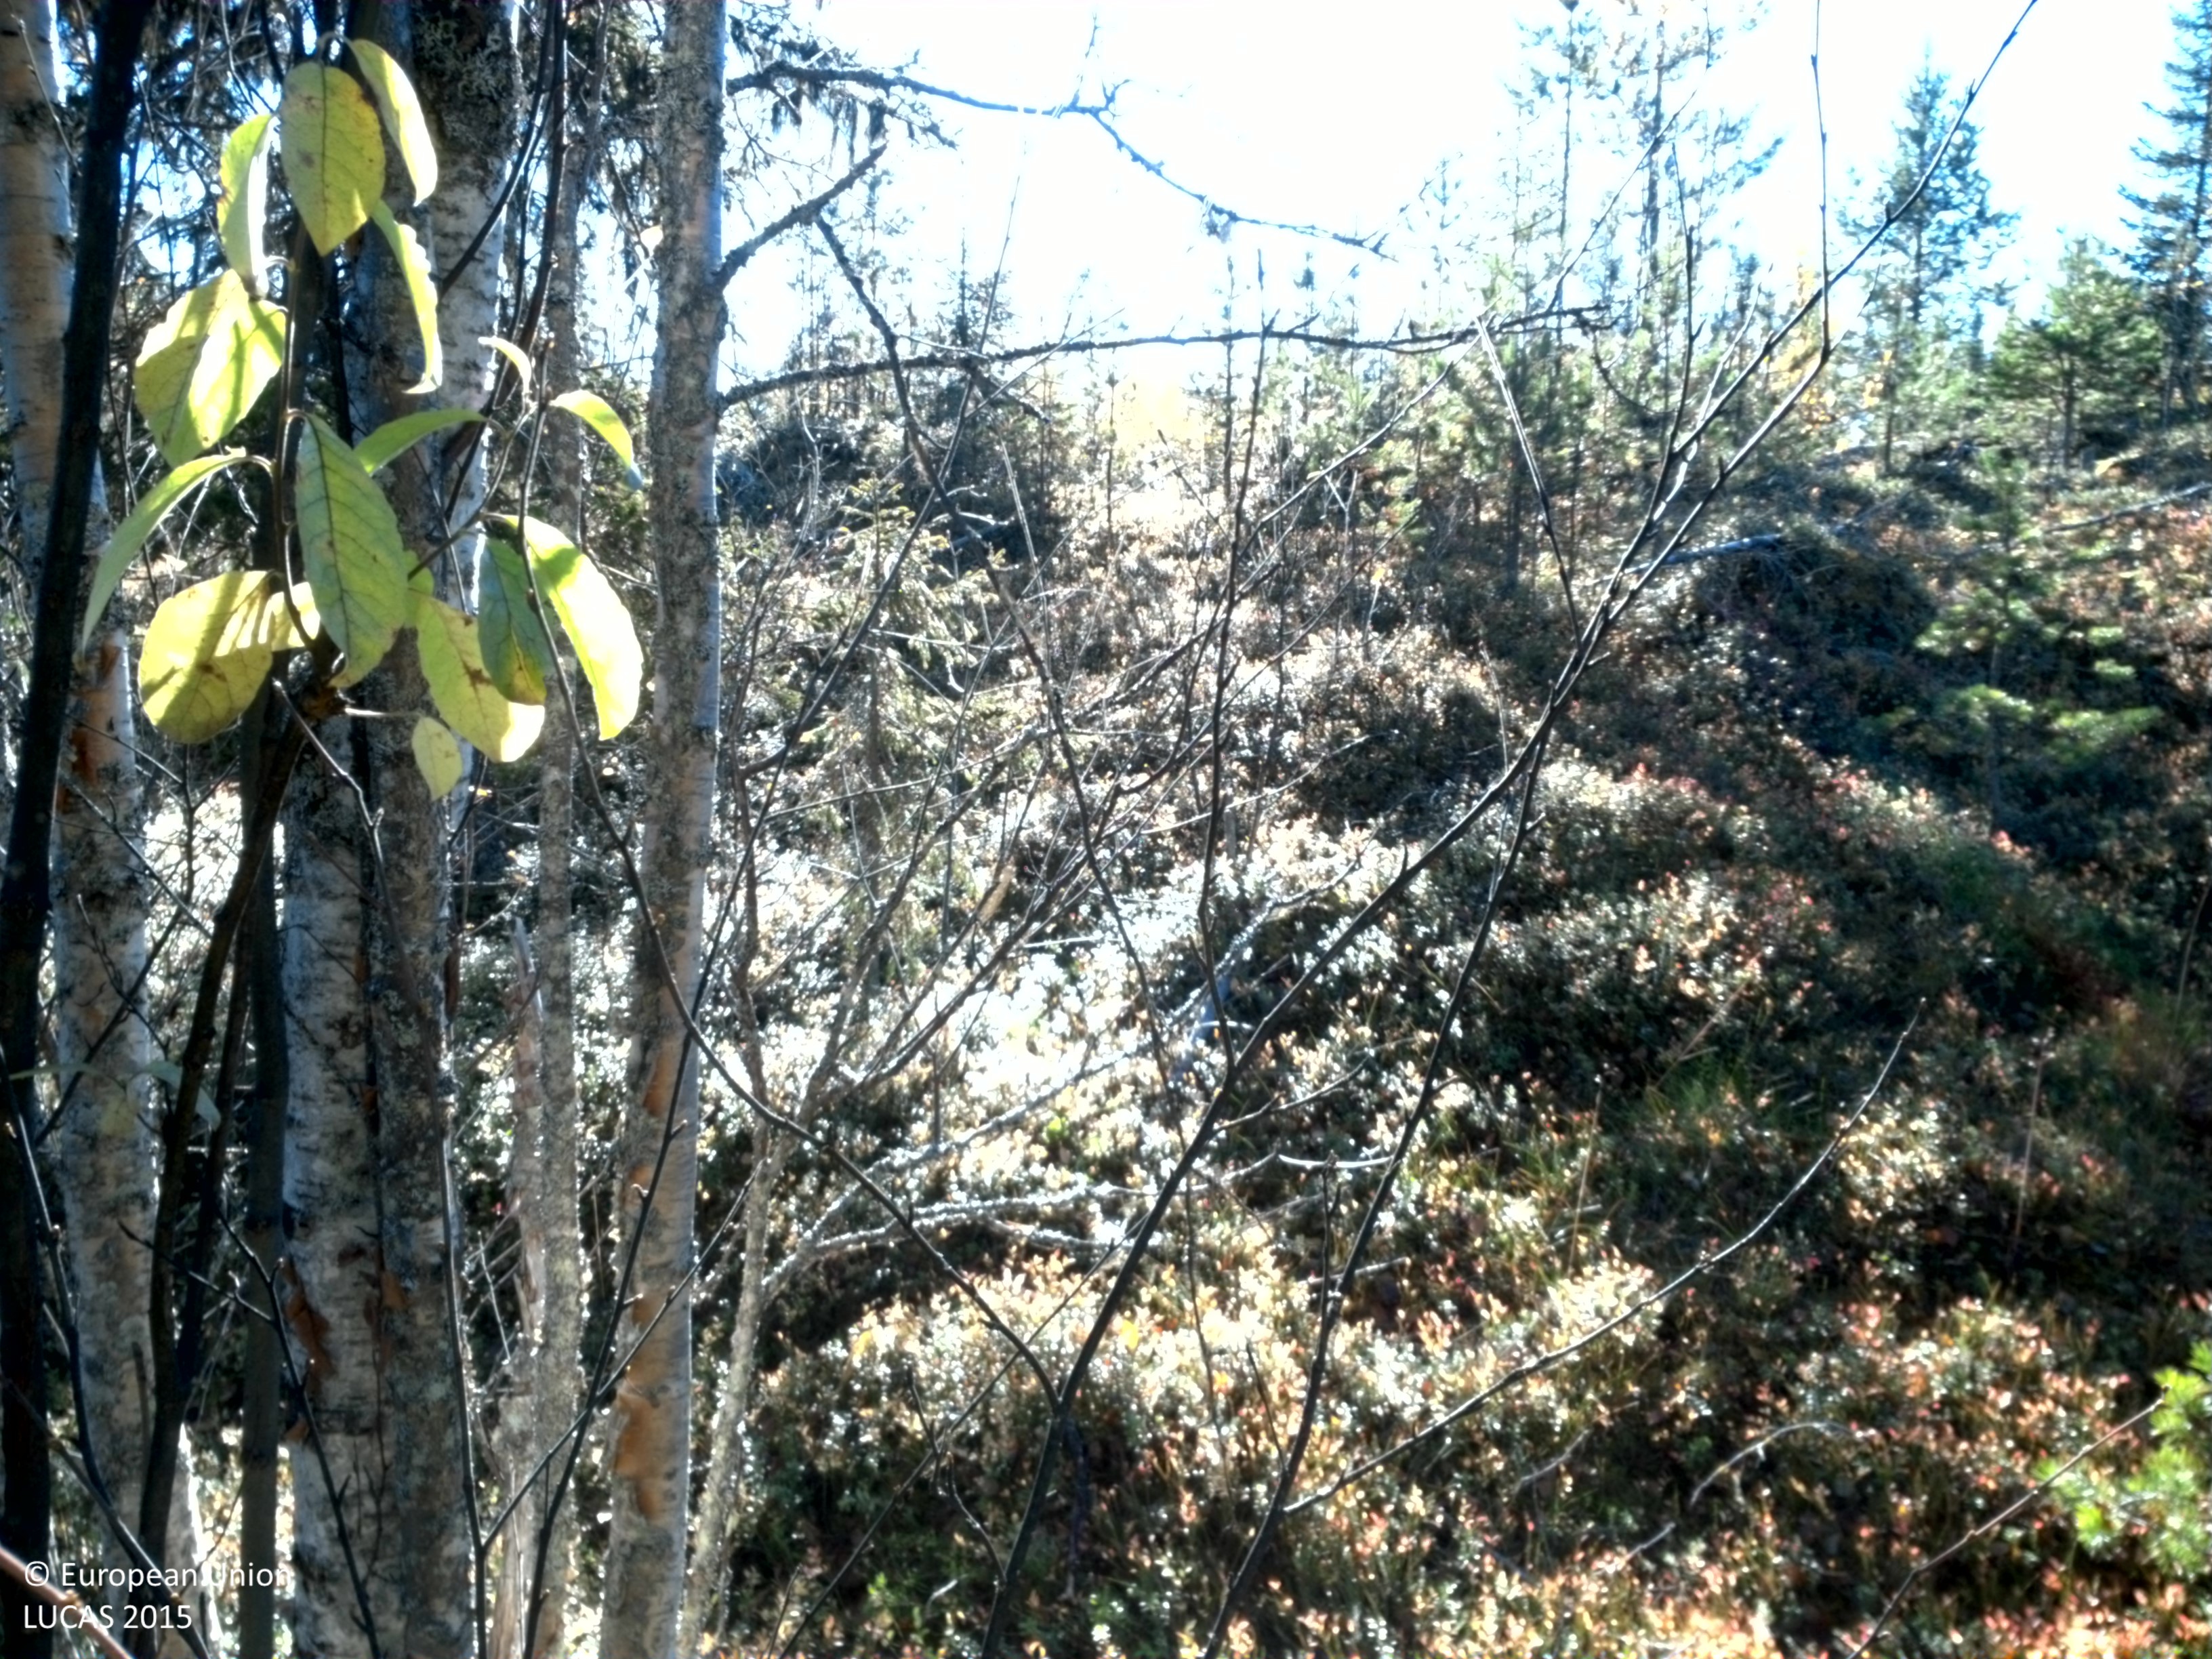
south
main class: Woodland
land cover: Spruce dominated mixed woodland
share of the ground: 25 - 50 %
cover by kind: shrubs 50 %, coniferous forest trees 20 %, broadleaved forest trees 15 %, lichens and mosses 10 %, herbaceous plants 5 %
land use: Forestry
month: September
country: SE
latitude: 64.9681
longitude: 17.8221
